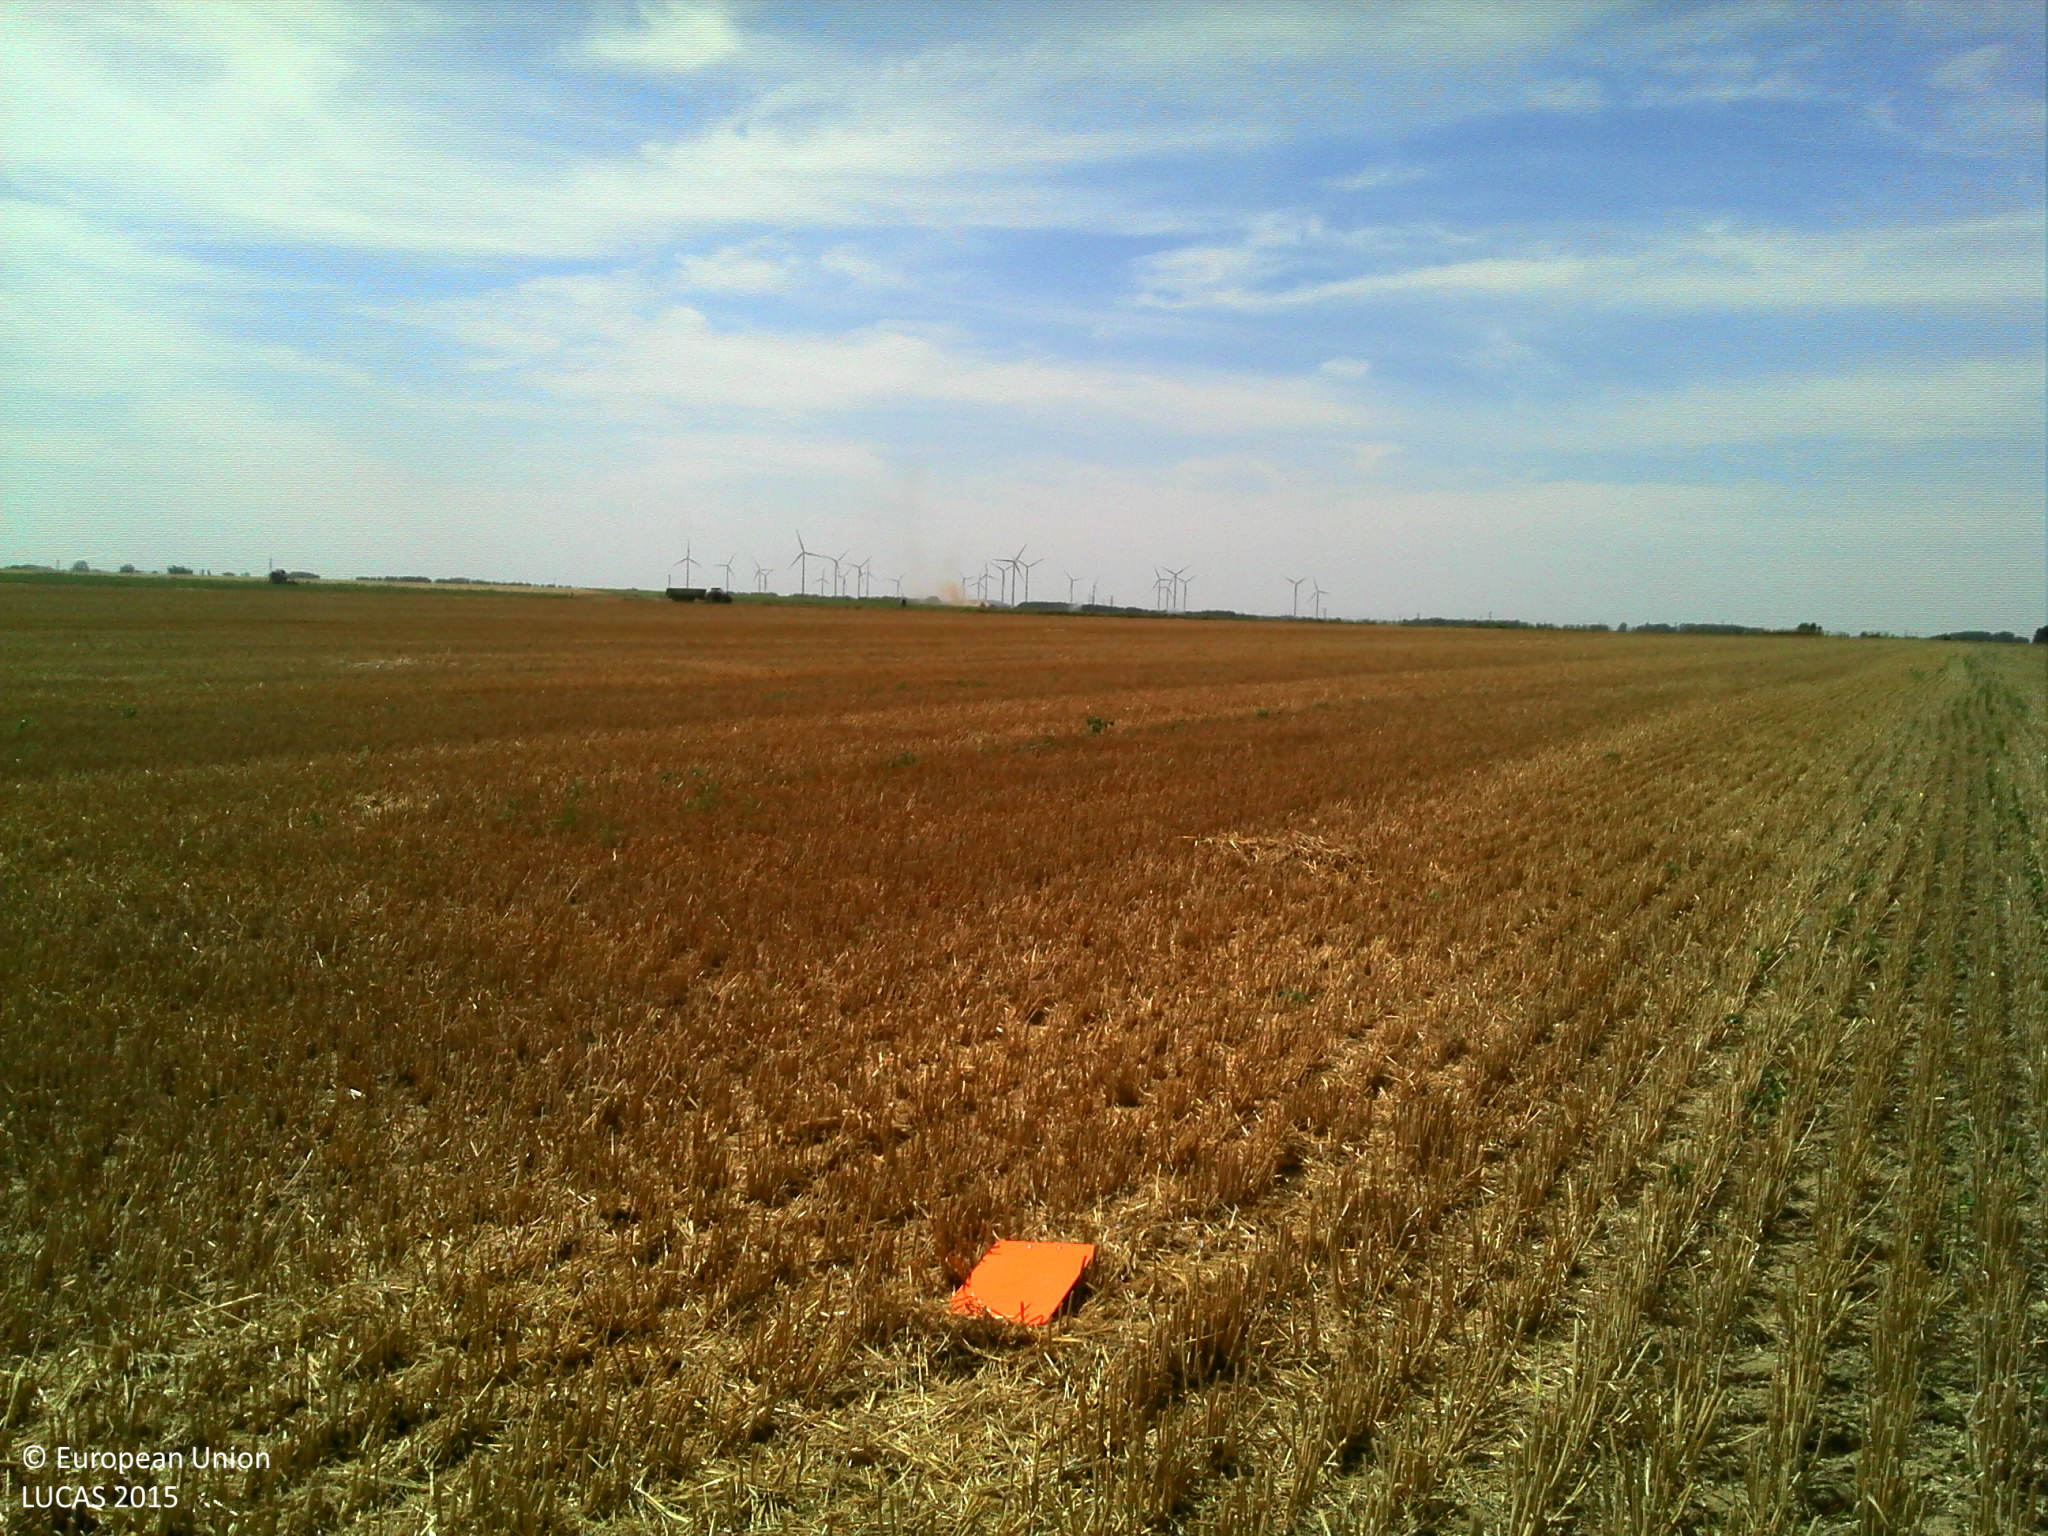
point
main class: Cropland
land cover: Common wheat
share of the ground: > 75 %
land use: Agriculture (excluding fallow land and kitchen gardens)
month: August
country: FR
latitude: 49.7068
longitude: 2.8483
